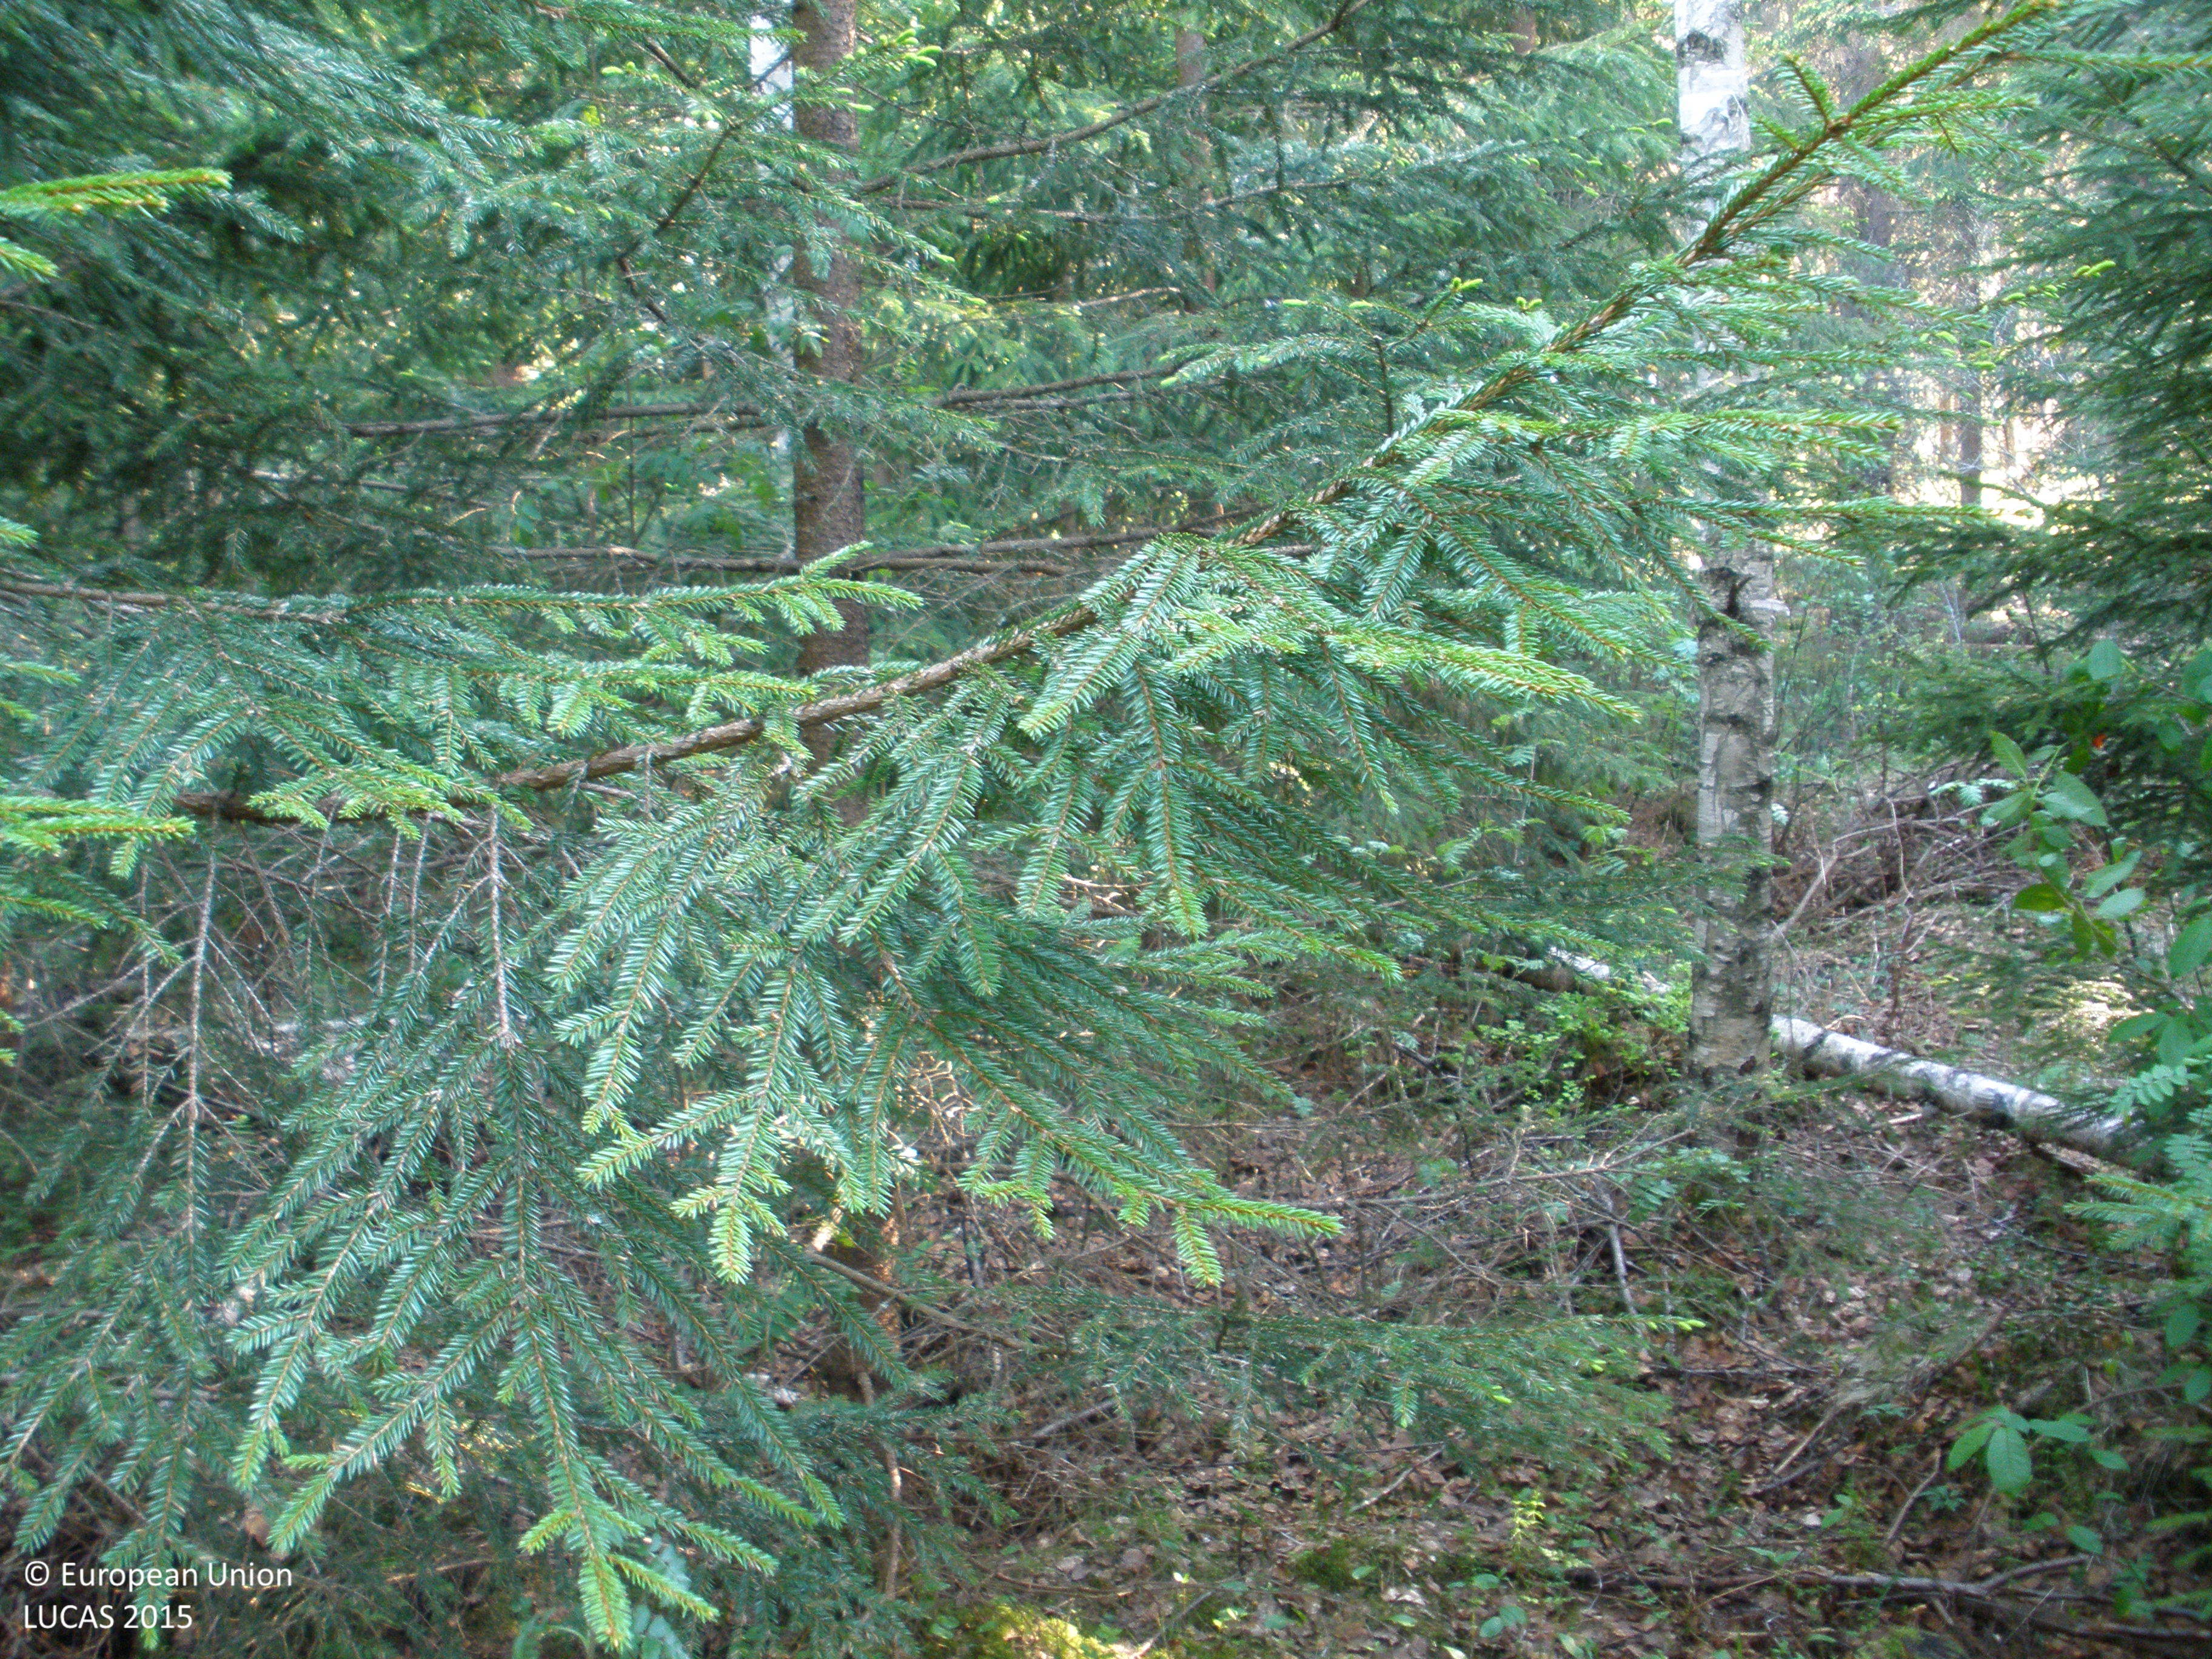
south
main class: Woodland
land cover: Spruce dominated coniferous woodland
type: boreal forest
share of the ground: > 75 %
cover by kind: coniferous forest trees 80 %, broadleaved forest trees 10 %, herbaceous plants 10 %
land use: Forestry
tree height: > 5 m
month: June
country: FI
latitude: 60.7690
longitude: 24.1031
